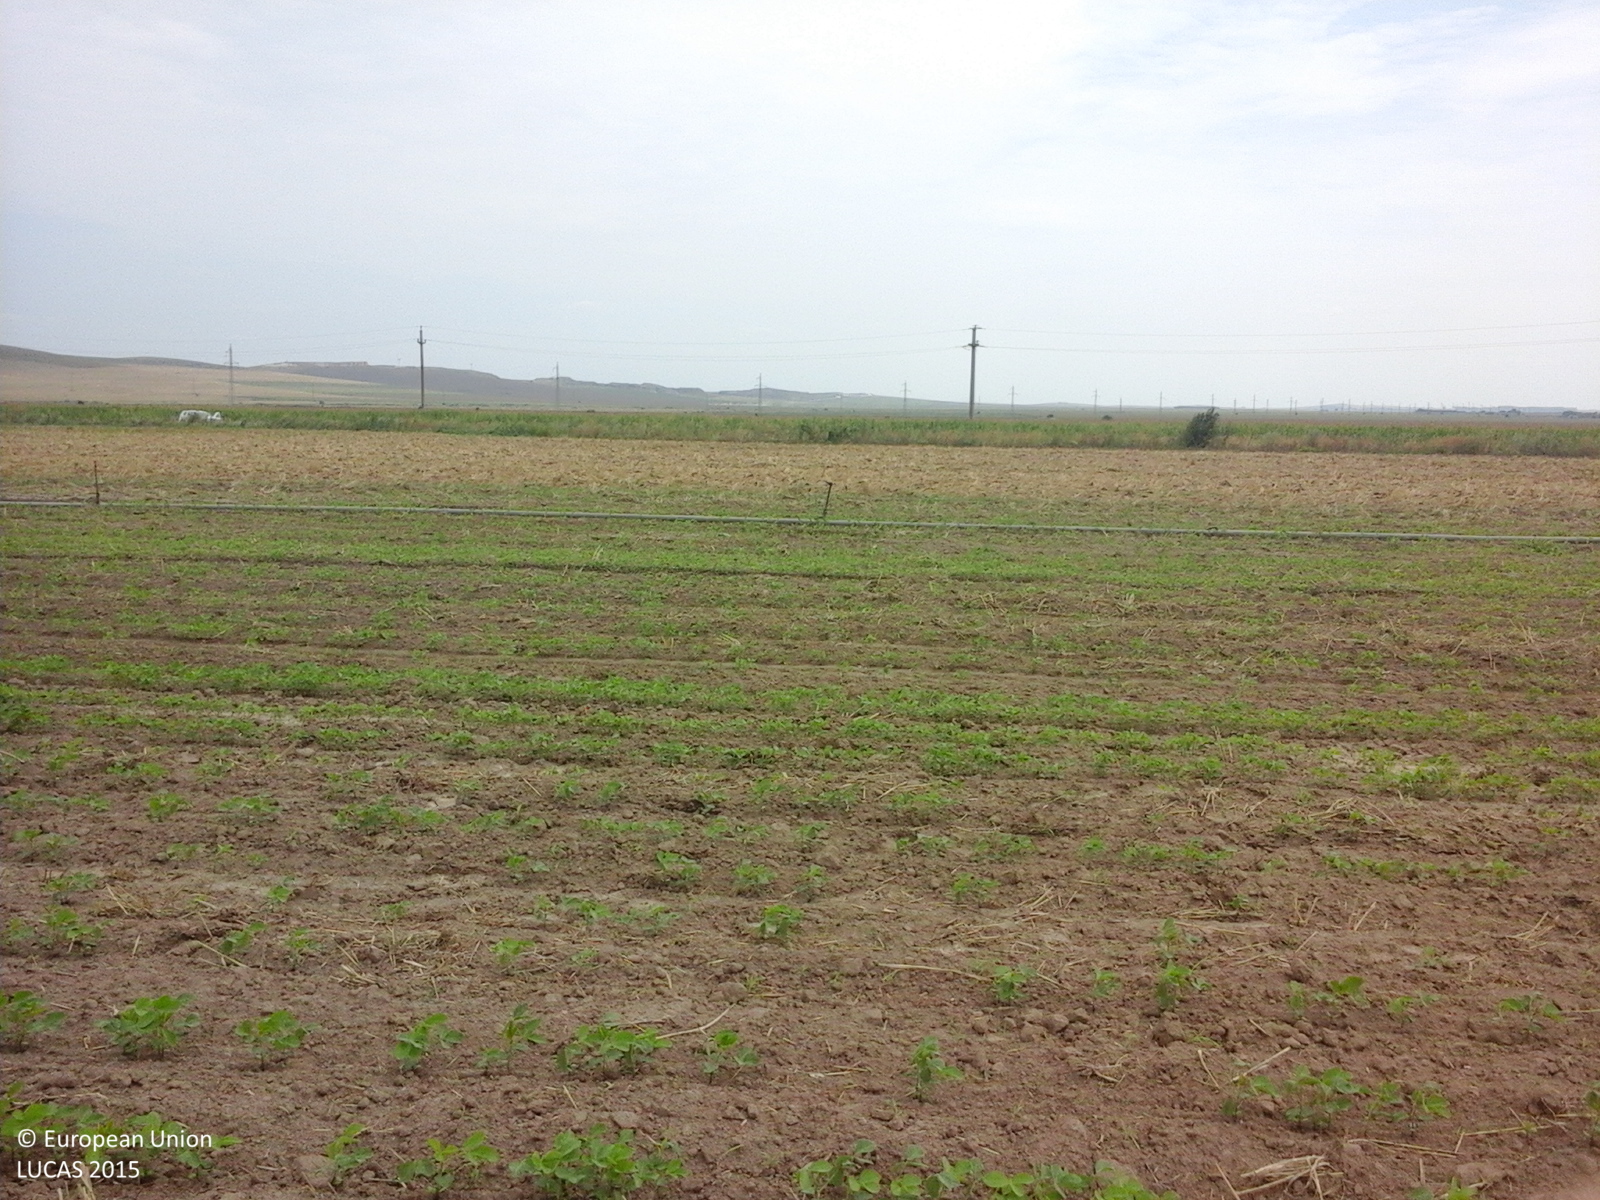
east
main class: Cropland
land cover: Soya
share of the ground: 10 - 25 %
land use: Agriculture (excluding fallow land and kitchen gardens)
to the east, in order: Soya; Common wheat; Tracks; Shruby margins; Single bushes/trees; Ditches and canals; Spontaneously vegetated surfaces; Tracks; Maize; Electric lines; Maize
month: August
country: RO
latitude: 45.0349
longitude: 28.9961
